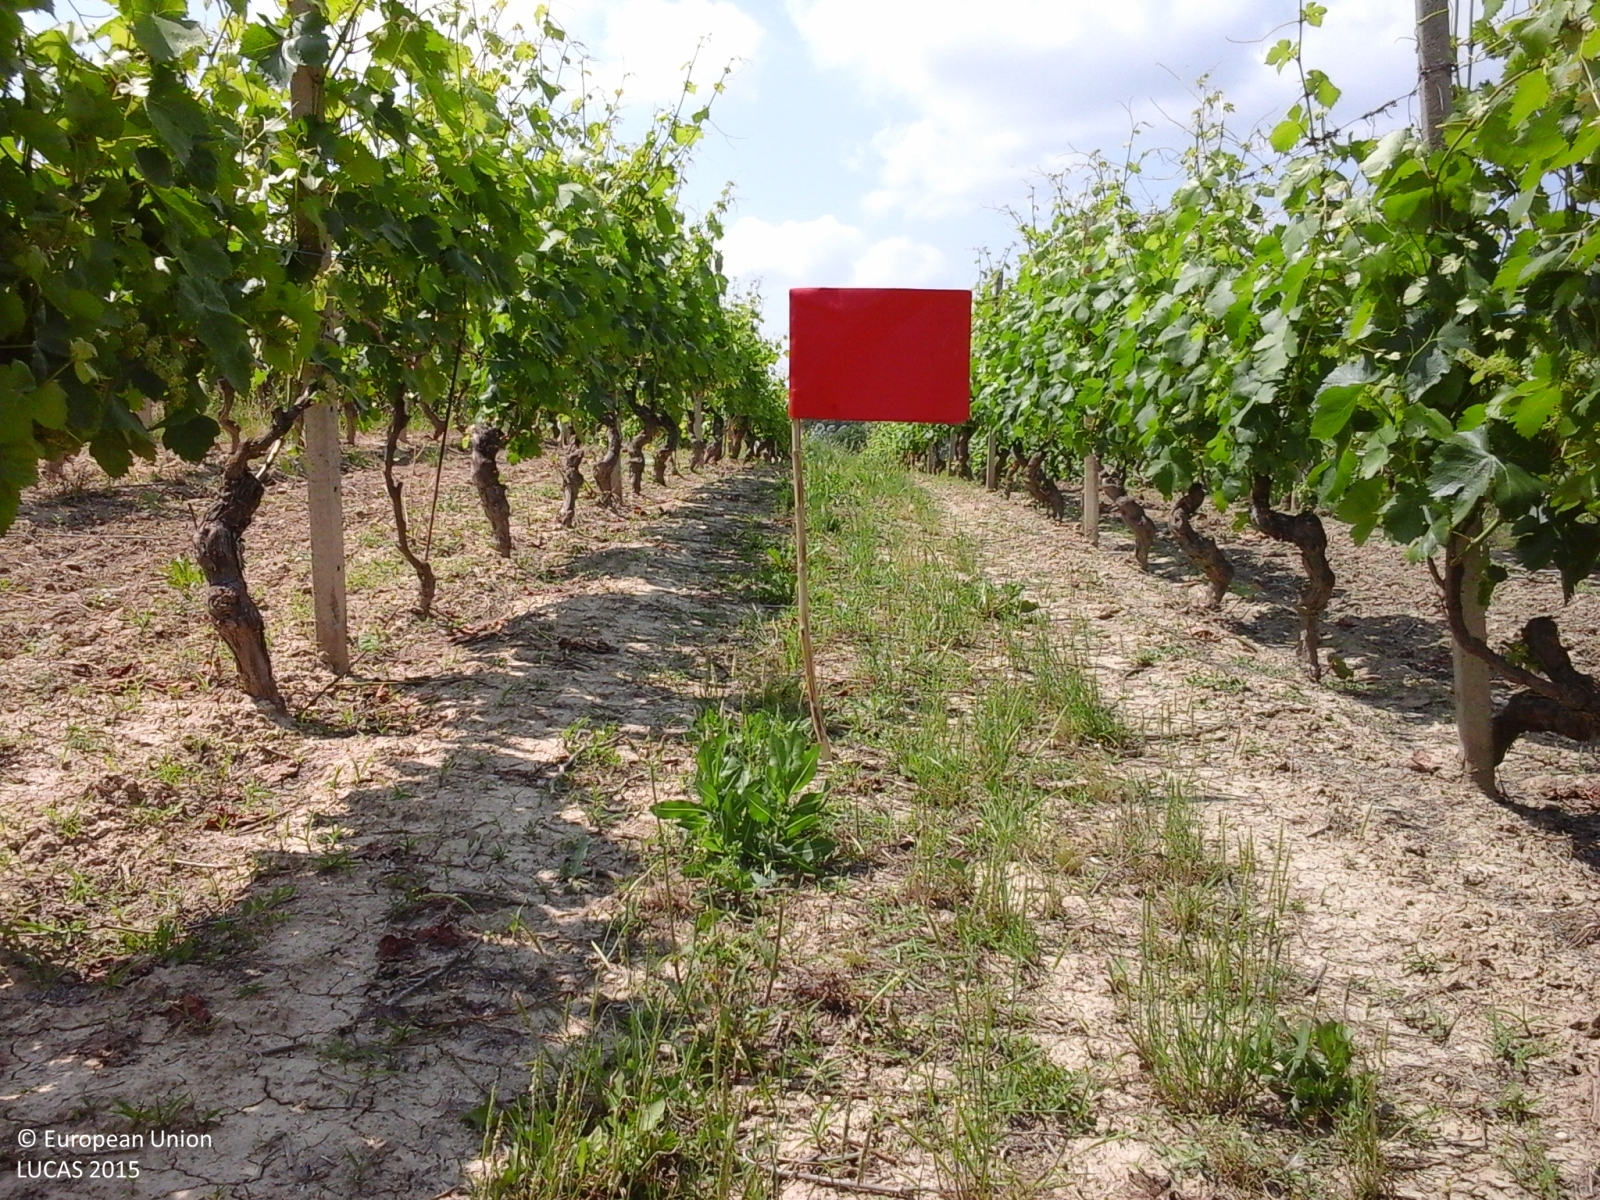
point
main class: Cropland
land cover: Vineyards
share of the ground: 50 - 75 %
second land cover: Grassland without tree/shrub cover
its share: 25 - 50 %
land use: Agriculture (excluding fallow land and kitchen gardens)
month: May
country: IT
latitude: 44.7682
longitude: 8.2220
